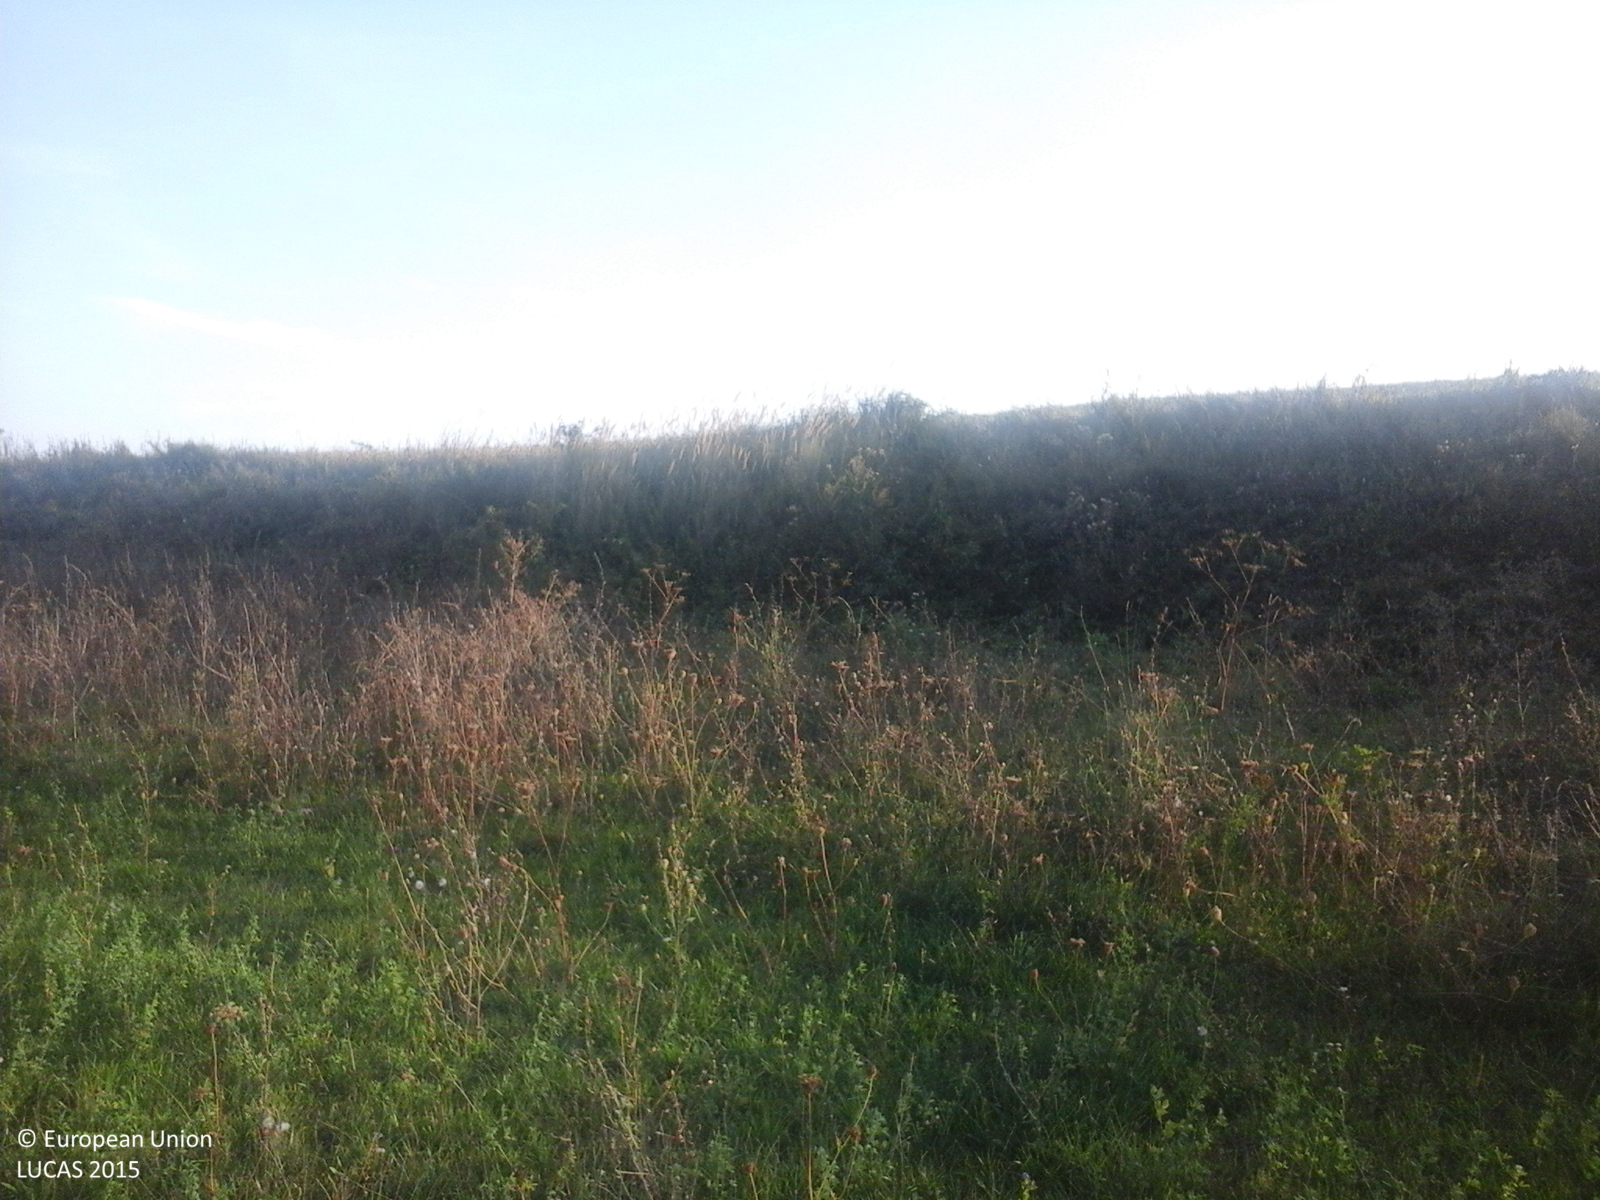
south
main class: Cropland
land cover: Lucerne
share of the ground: > 75 %
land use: Agriculture (excluding fallow land and kitchen gardens)
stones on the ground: < 10 %
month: September
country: RO
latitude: 46.7834
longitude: 23.9490
